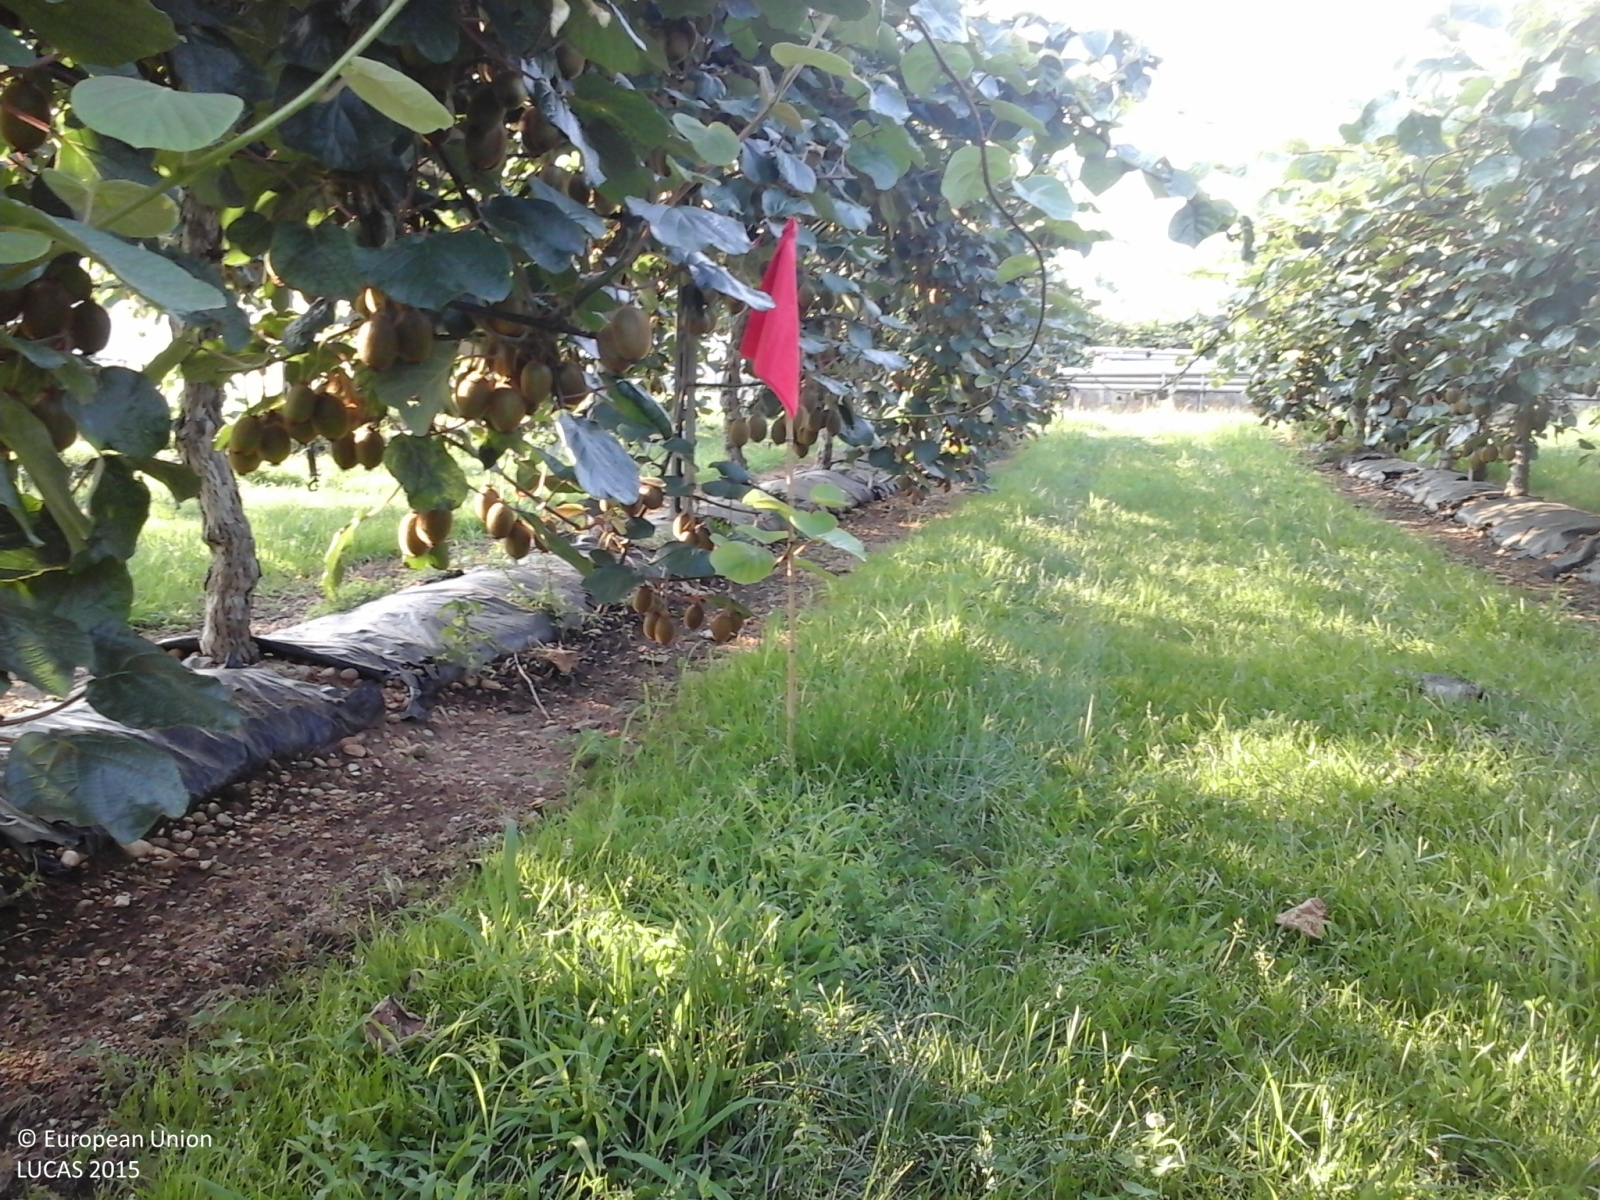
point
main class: Cropland
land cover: Other fruit trees and berries
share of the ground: > 75 %
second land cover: Grassland without tree/shrub cover
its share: > 75 %
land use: Agriculture (excluding fallow land and kitchen gardens)
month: July
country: IT
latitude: 45.3741
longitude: 10.9305
